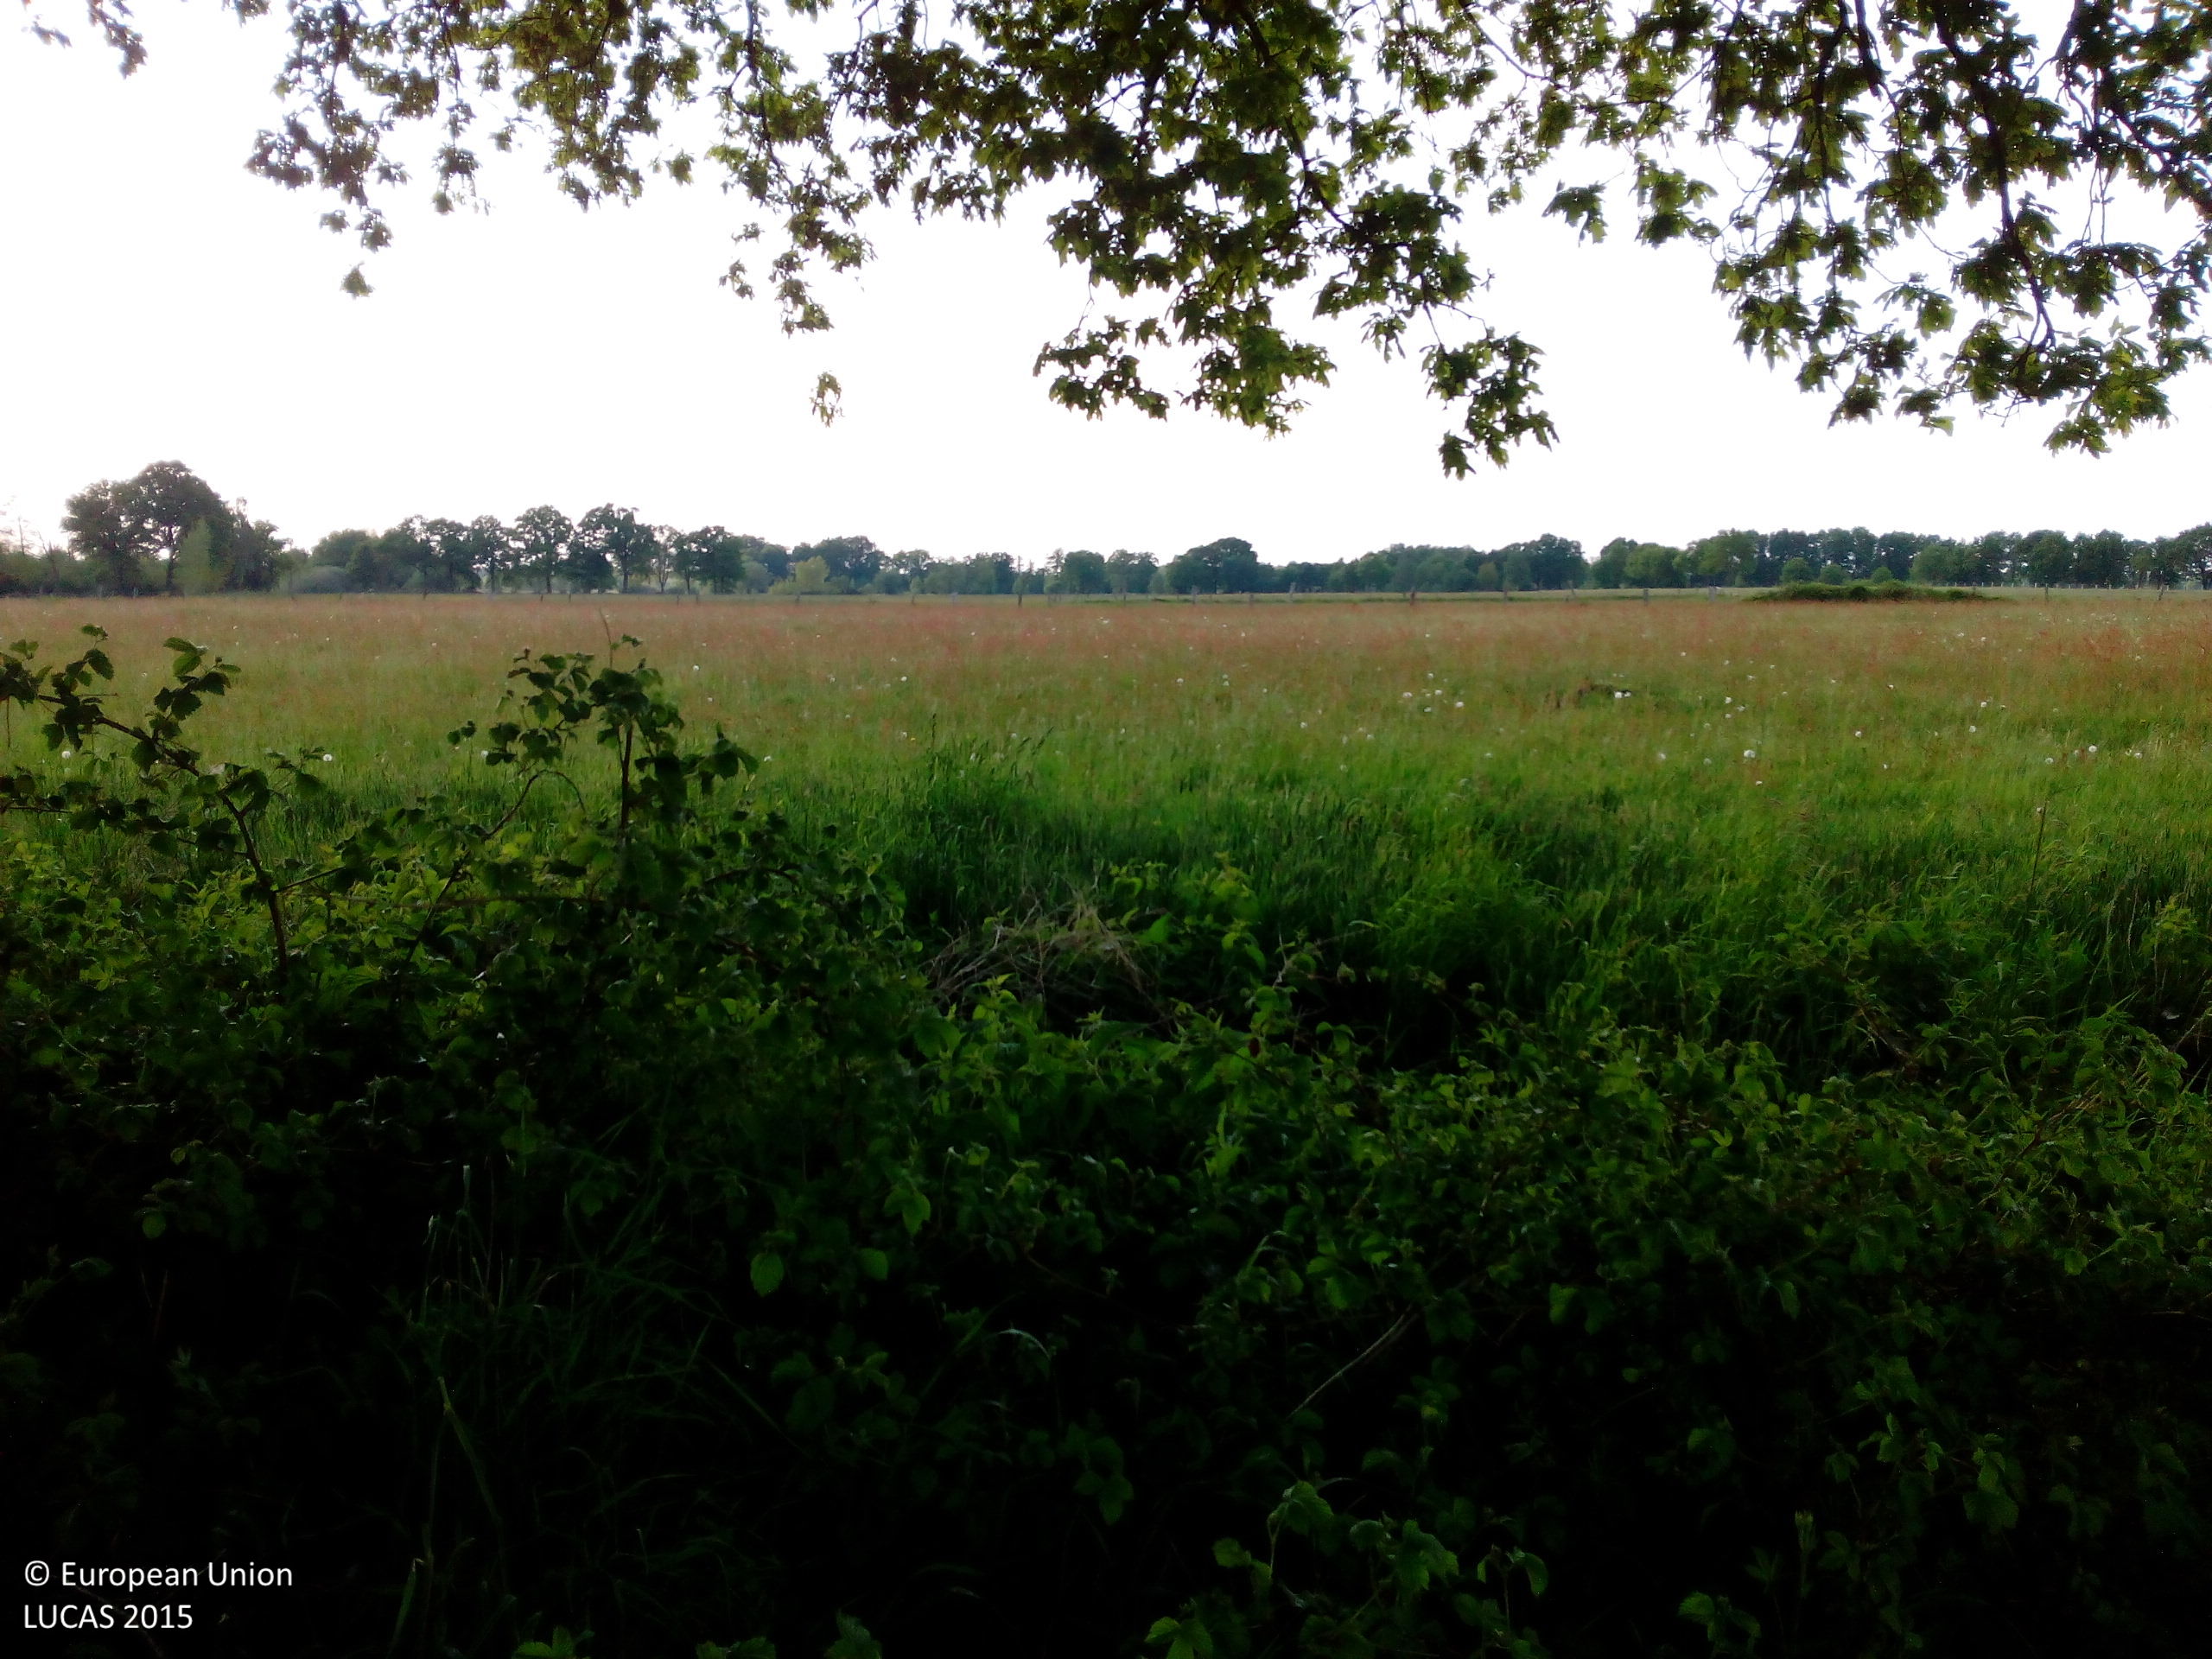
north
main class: Woodland
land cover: Broadleaved woodland
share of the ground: > 75 %
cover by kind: broadleaved forest trees 60 %, shrubs 20 %, herbaceous plants 20 %
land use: Agriculture (excluding fallow land and kitchen gardens)
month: May
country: DE
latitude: 52.1707
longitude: 7.4708
